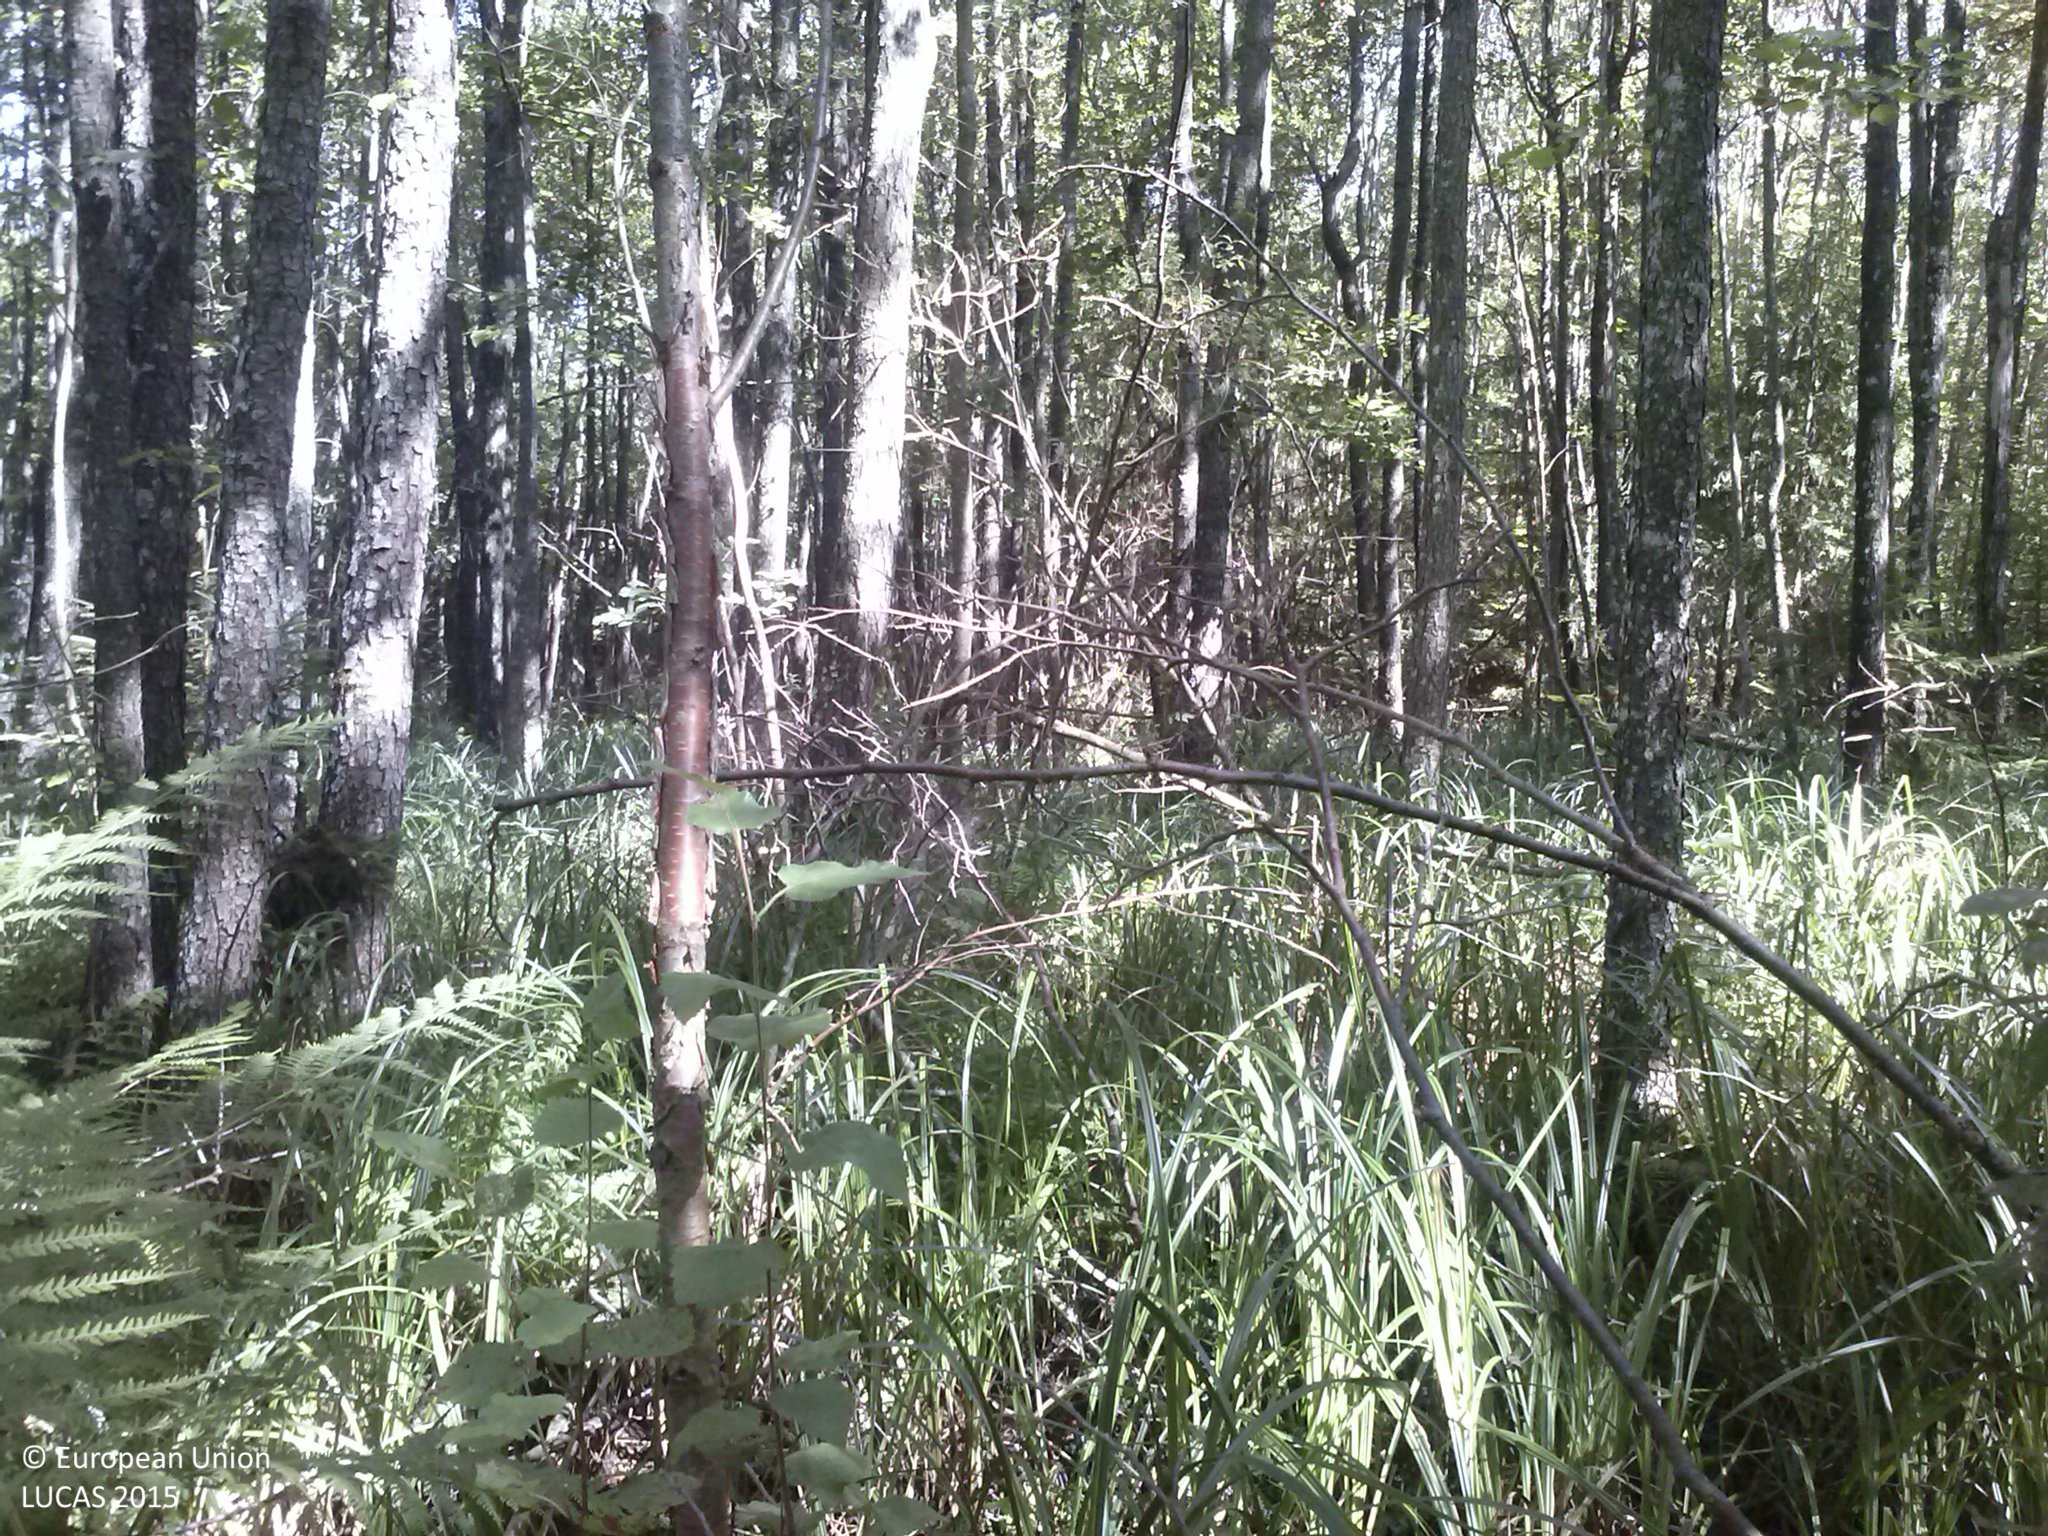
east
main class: Woodland
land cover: Broadleaved woodland
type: non-riverine alder, birch or aspen forest
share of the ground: > 75 %
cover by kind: broadleaved forest trees 75 %, herbaceous plants 25 %
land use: Forestry
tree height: > 5 m
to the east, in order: Broadleaved woodland; Artificial constructions in urban areas; Broadleaved woodland; Spontaneously vegetated surfaces; Grassland without tree/shrub cover
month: August
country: LV
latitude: 56.1998
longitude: 26.8751
